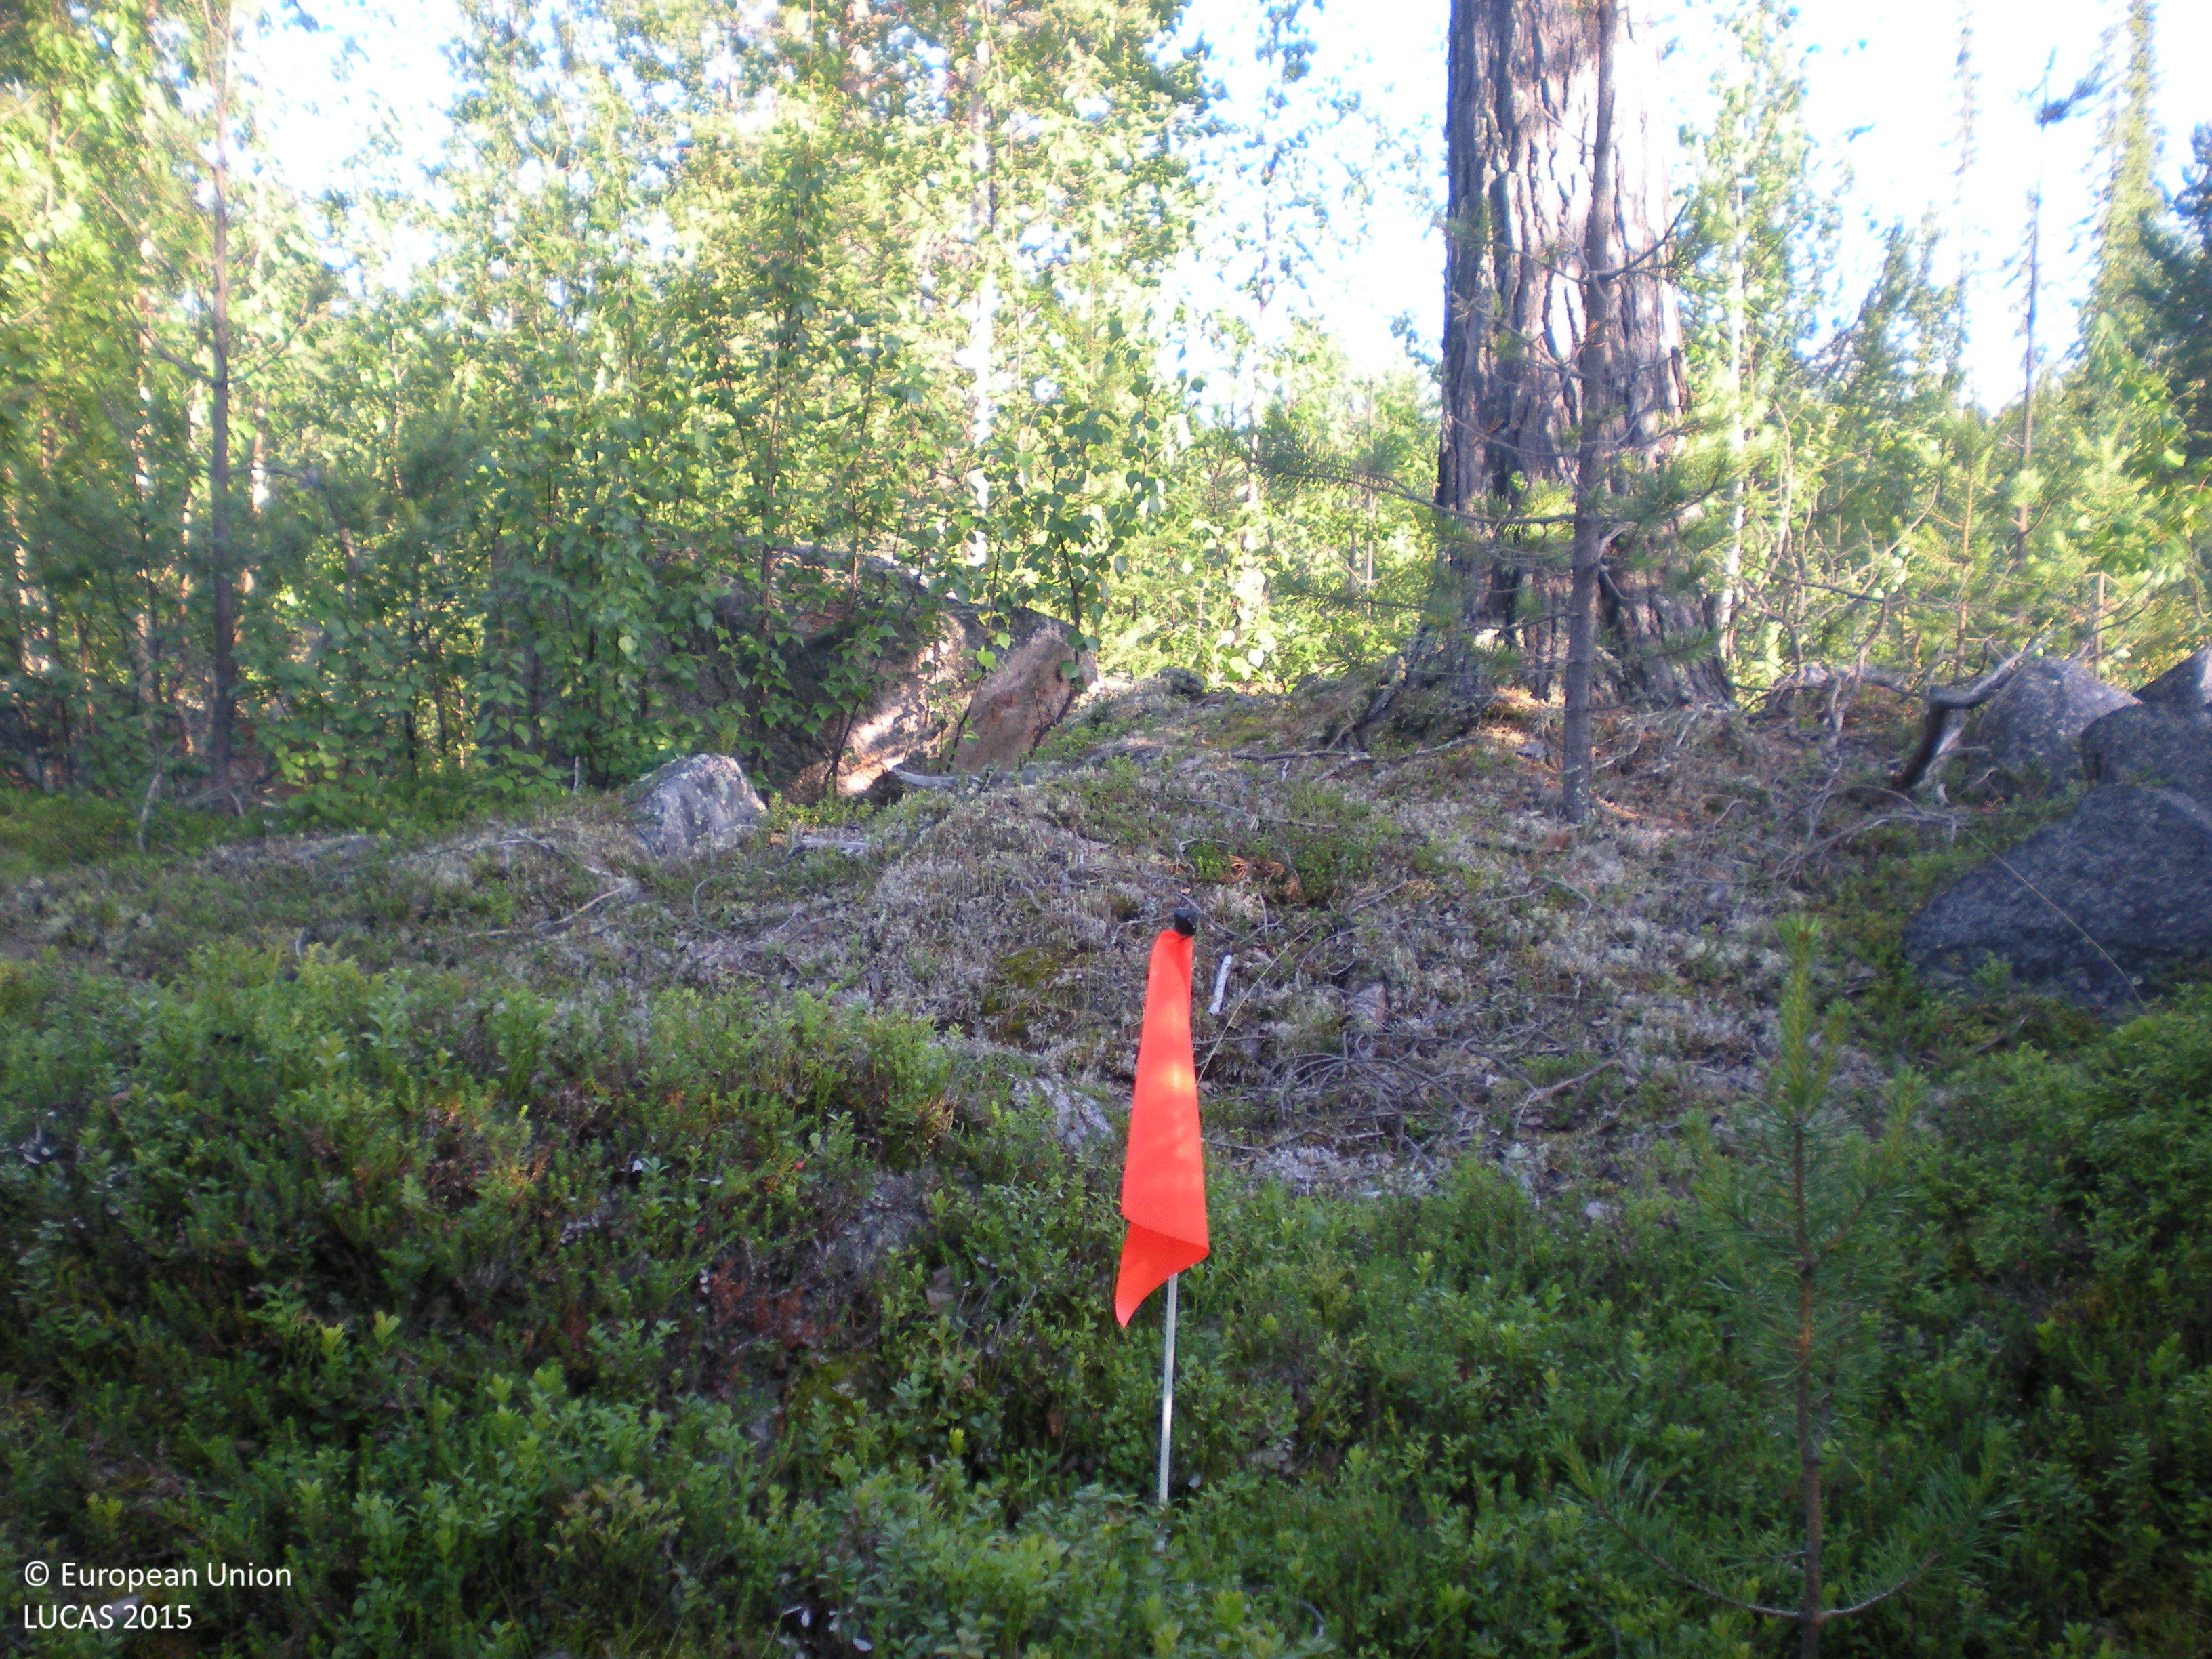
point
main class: Woodland
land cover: Pine dominated mixed woodland
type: boreal forest
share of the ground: 25 - 50 %
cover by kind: shrubs 40 %, coniferous forest trees 20 %, broadleaved forest trees 15 %, consolidated bare surface 15 %, lichens and mosses 10 %
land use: Forestry
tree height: > 5 m
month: August
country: SE
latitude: 66.2831
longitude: 18.0855
